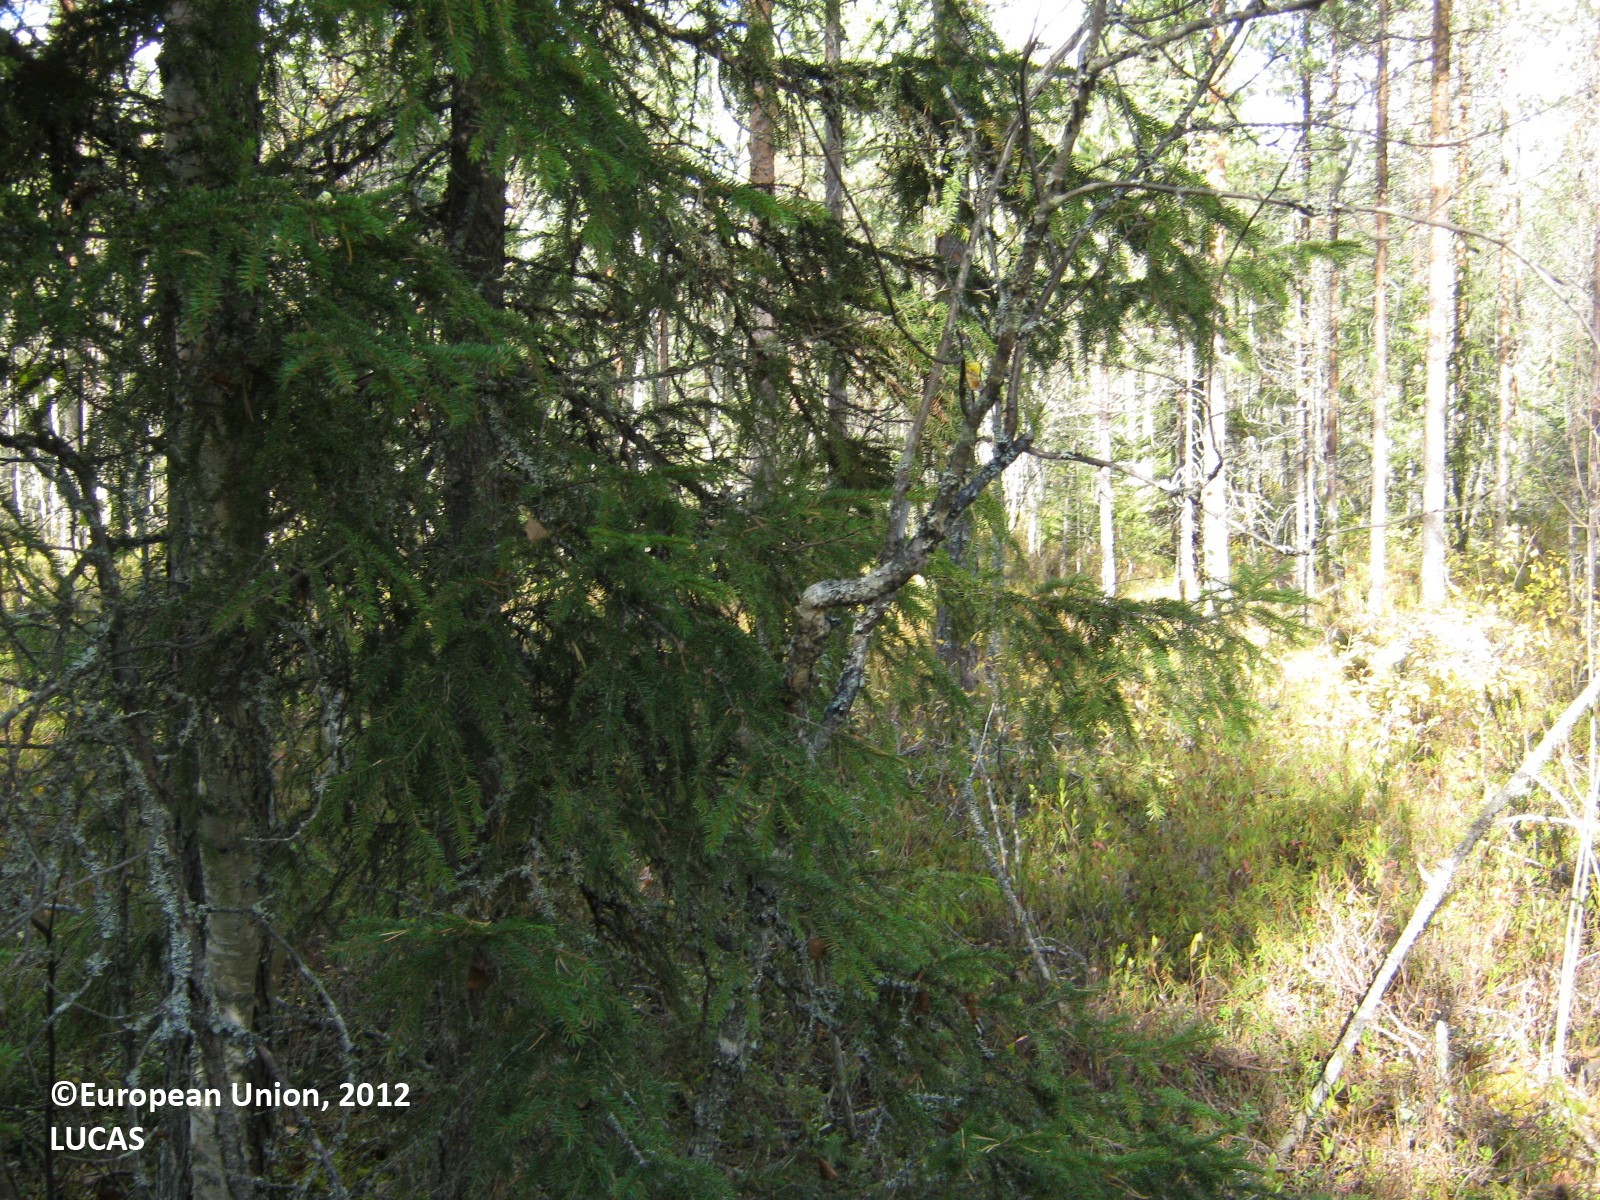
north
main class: Woodland
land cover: Pine dominated coniferous woodland
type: boreal forest
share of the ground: > 75 %
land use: Forestry
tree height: > 5 m
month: September
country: FI
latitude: 63.4338
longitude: 25.9662
